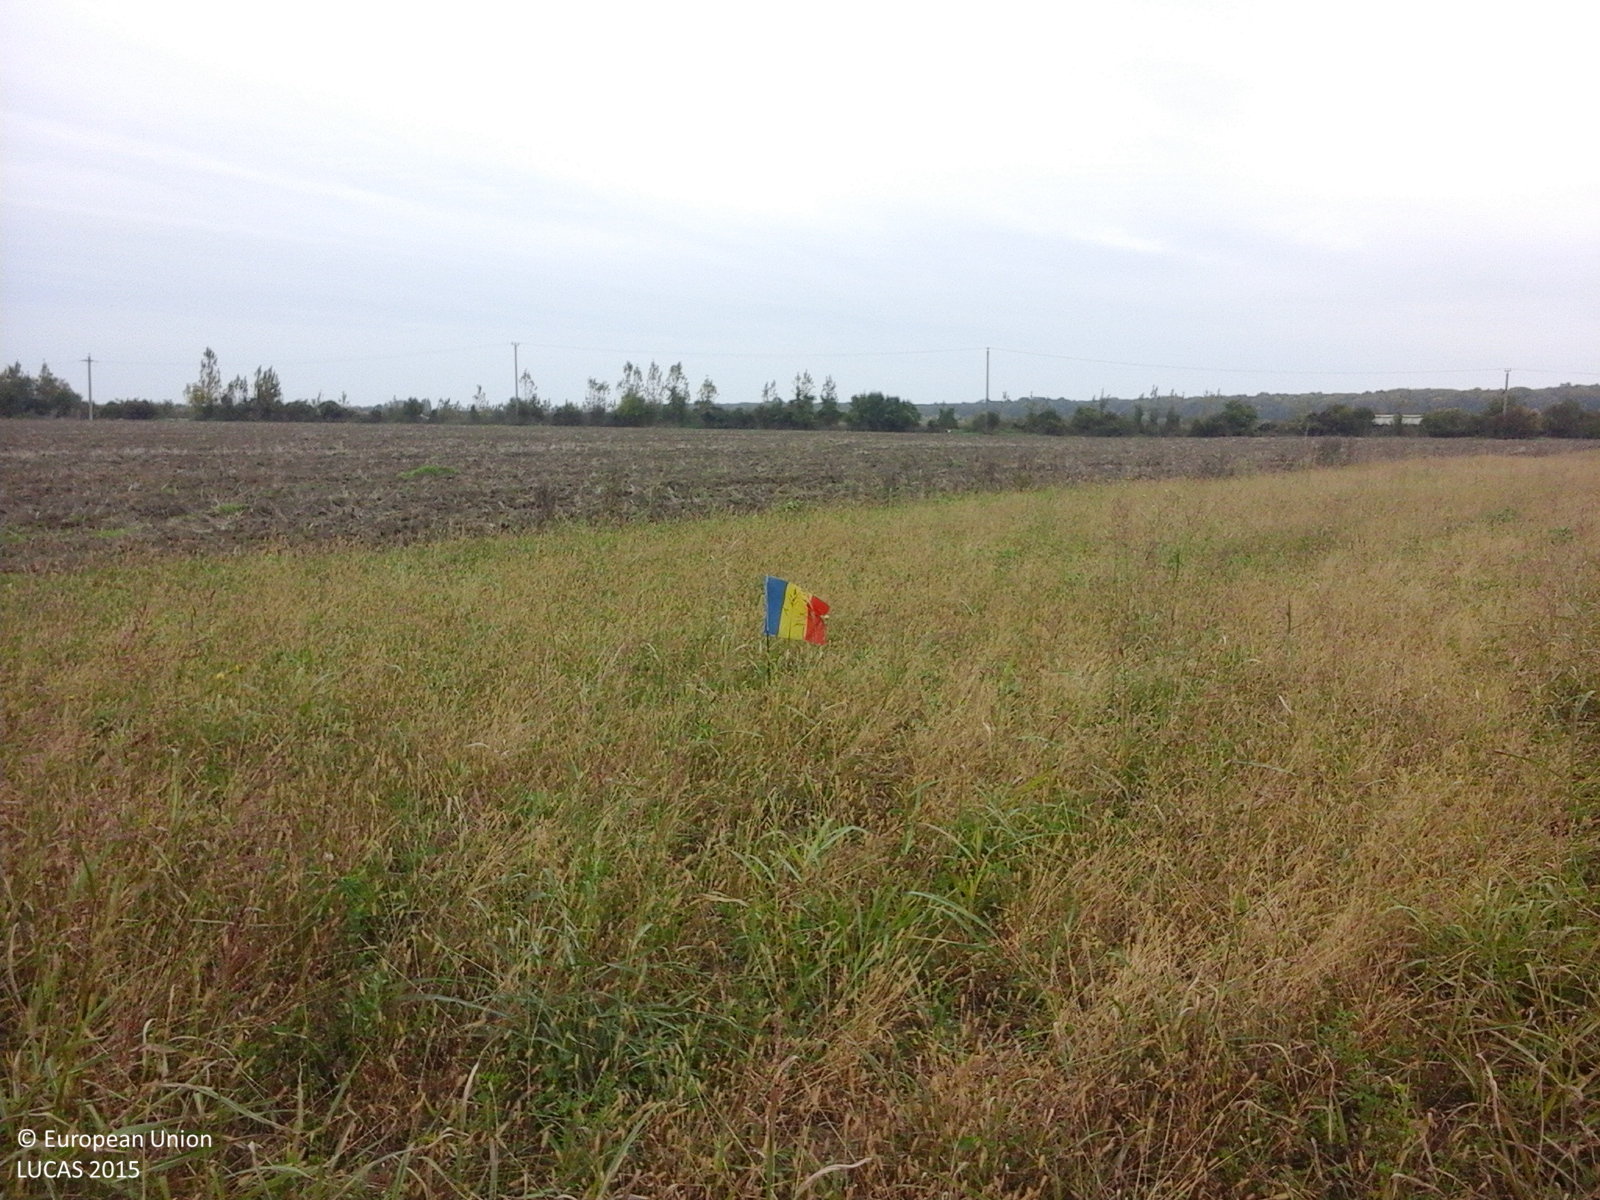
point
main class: Grassland
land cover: Spontaneously vegetated surfaces
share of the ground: > 75 %
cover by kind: herbaceous plants 100 %
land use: Fallow land
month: October
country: RO
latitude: 44.7990
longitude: 26.0487
